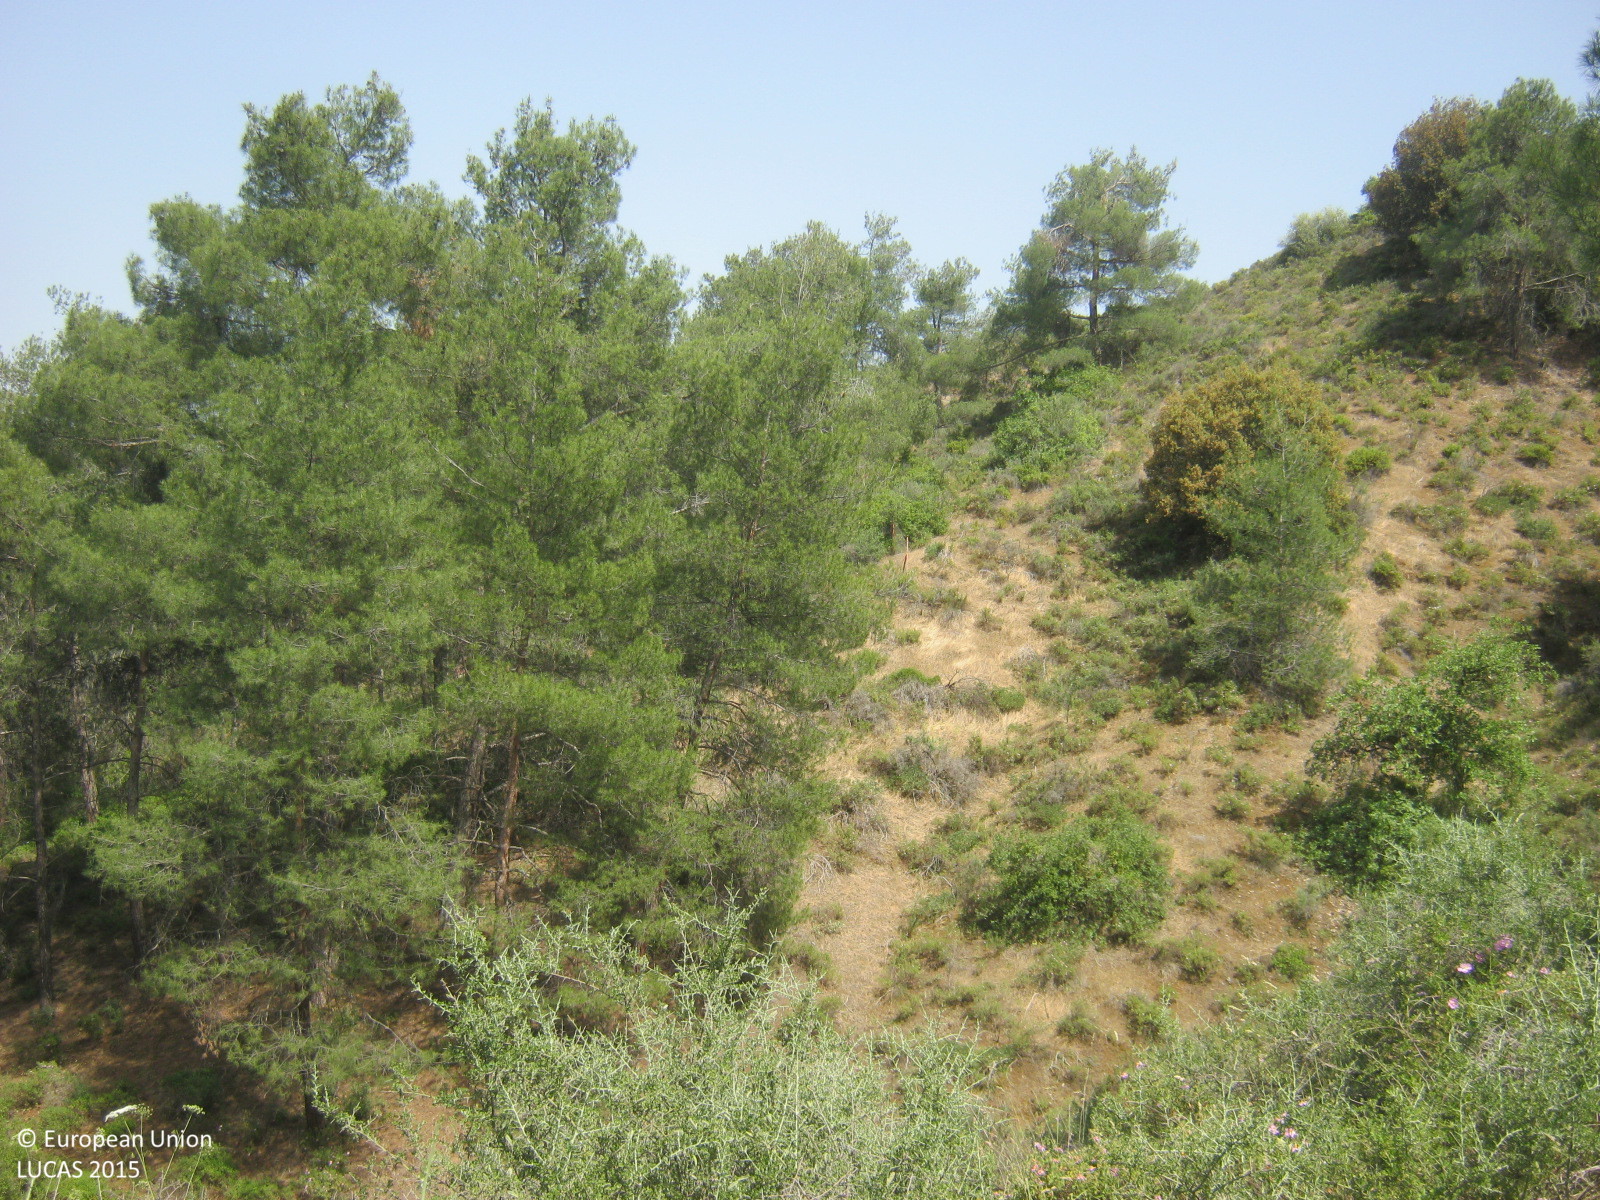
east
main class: Shrubland
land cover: Shrubland with sparse tree cover
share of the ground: > 75 %
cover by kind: shrubs 85 %, coniferous forest trees 5 %, herbaceous plants 5 %, unconsolidated bare surface 5 %
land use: Semi-natural and natural areas not in use
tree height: > 5 m
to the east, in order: Shrubland with sparse tree cover; Pine dominated coniferous woodland; Fences; Pine dominated coniferous woodland; Rivers and streams; Shrubland with sparse tree cover; Pine dominated coniferous woodland; Paved roads, cycling and walking lanes
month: May
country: CY
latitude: 35.0105
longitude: 32.8861
